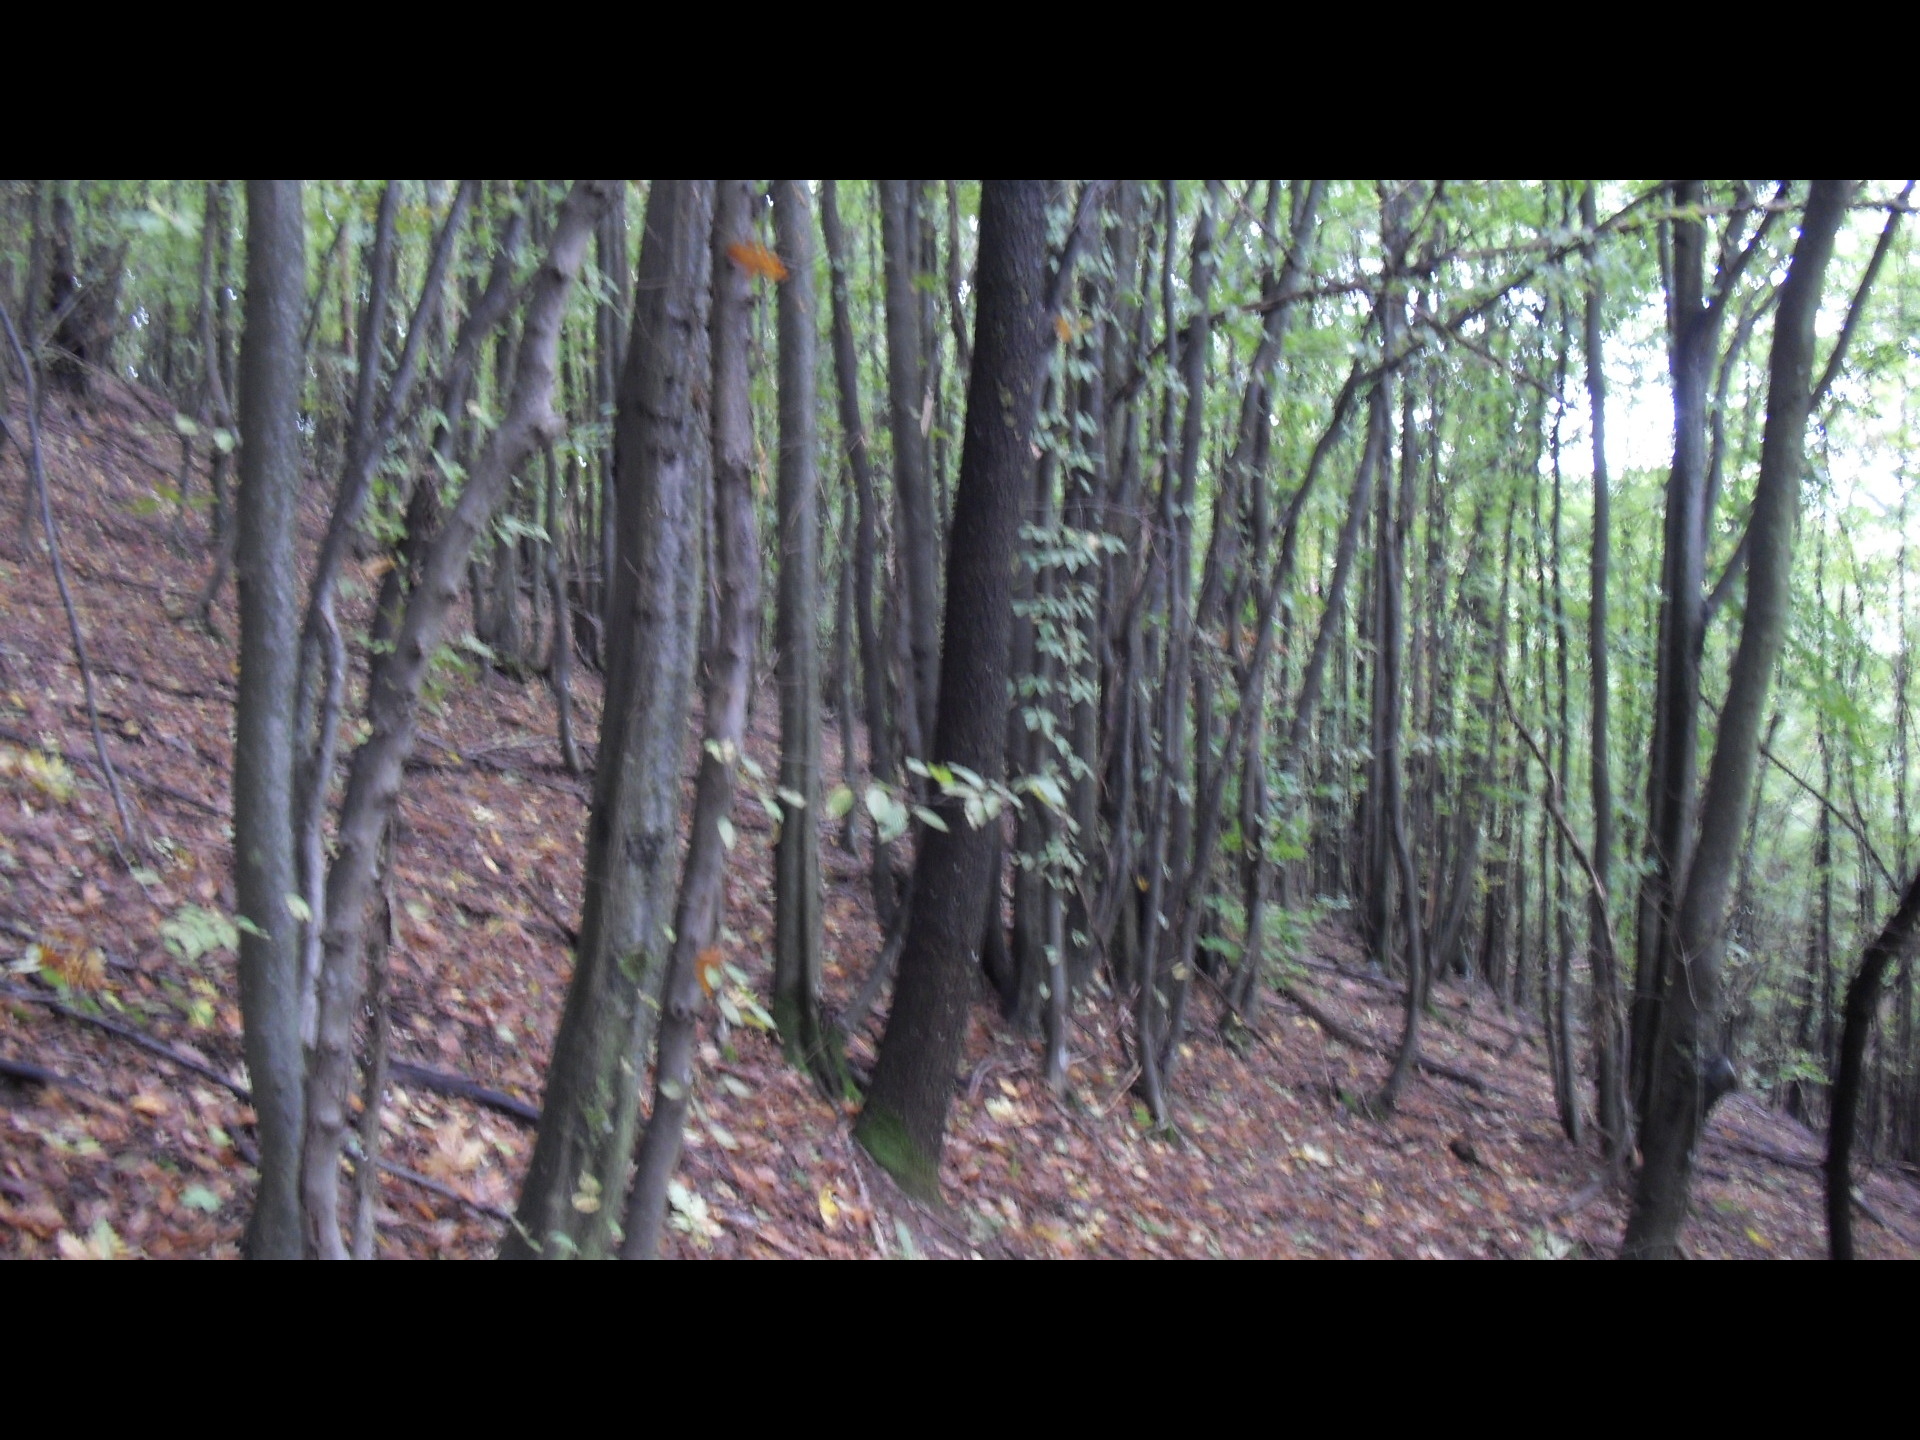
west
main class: Woodland
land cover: Broadleaved woodland
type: mesophytic deciduous forest
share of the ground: > 75 %
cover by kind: broadleaved forest trees 100 %
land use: Forestry
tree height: > 5 m
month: October
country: BG
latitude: 43.4836
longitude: 22.7814
